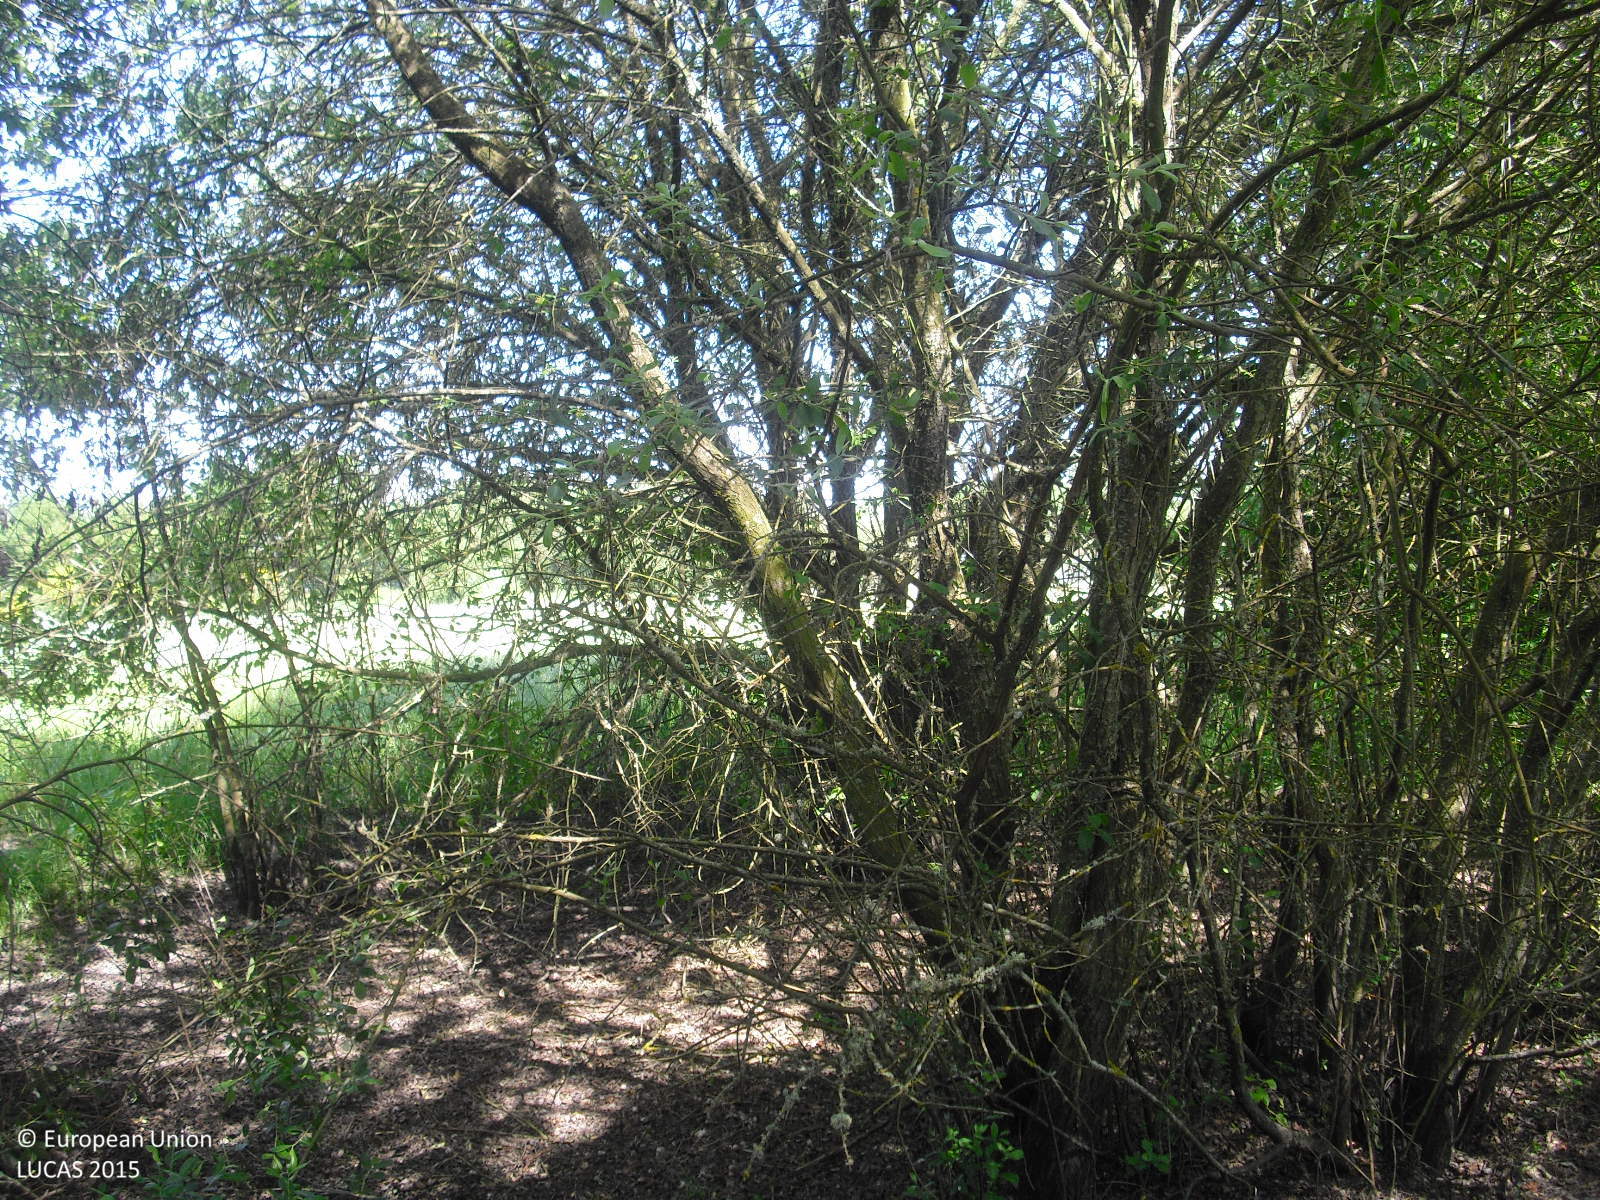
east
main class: Woodland
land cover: Broadleaved woodland
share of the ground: 50 - 75 %
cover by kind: broadleaved forest trees 70 %, herbaceous plants 20 %, shrubs 10 %
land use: Abandoned areas
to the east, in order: Broadleaved woodland; Temporary grasslands; Shruby margins; Spontaneously vegetated surfaces; Grassland without tree/shrub cover; Tracks; Single bushes/trees; Spontaneously vegetated surfaces; Ditches and canals; Grass margins; Paved roads, cycling and walking lanes; Artificial constructions; Grass margins; Electric lines; Shruby margins; Rivers and streams; Grassland without tree/shrub cover; Electric lines; Grassland without tree/shrub cover
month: May
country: ES
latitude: 42.0932
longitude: -7.7094
